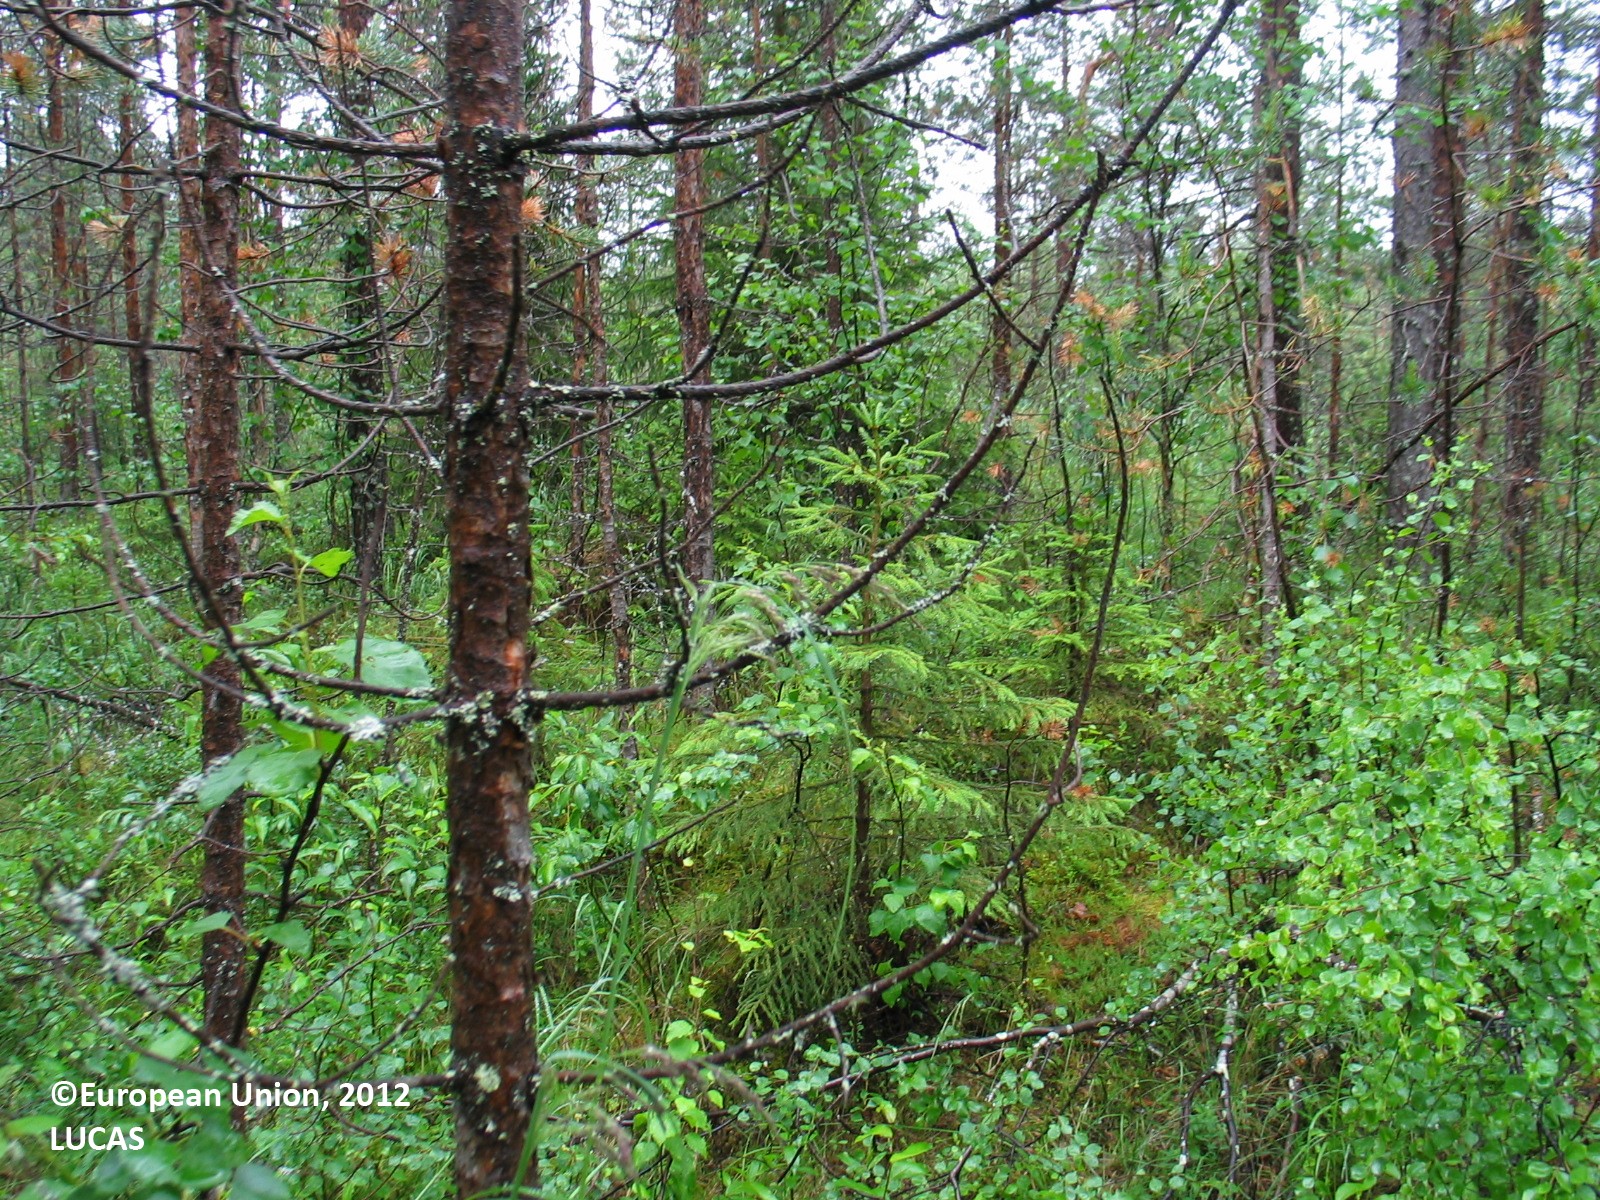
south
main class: Woodland
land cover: Pine dominated coniferous woodland
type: mire and swamp forests
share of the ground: 50 - 75 %
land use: Forestry
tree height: > 5 m
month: July
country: FI
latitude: 66.0735
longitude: 24.8843
